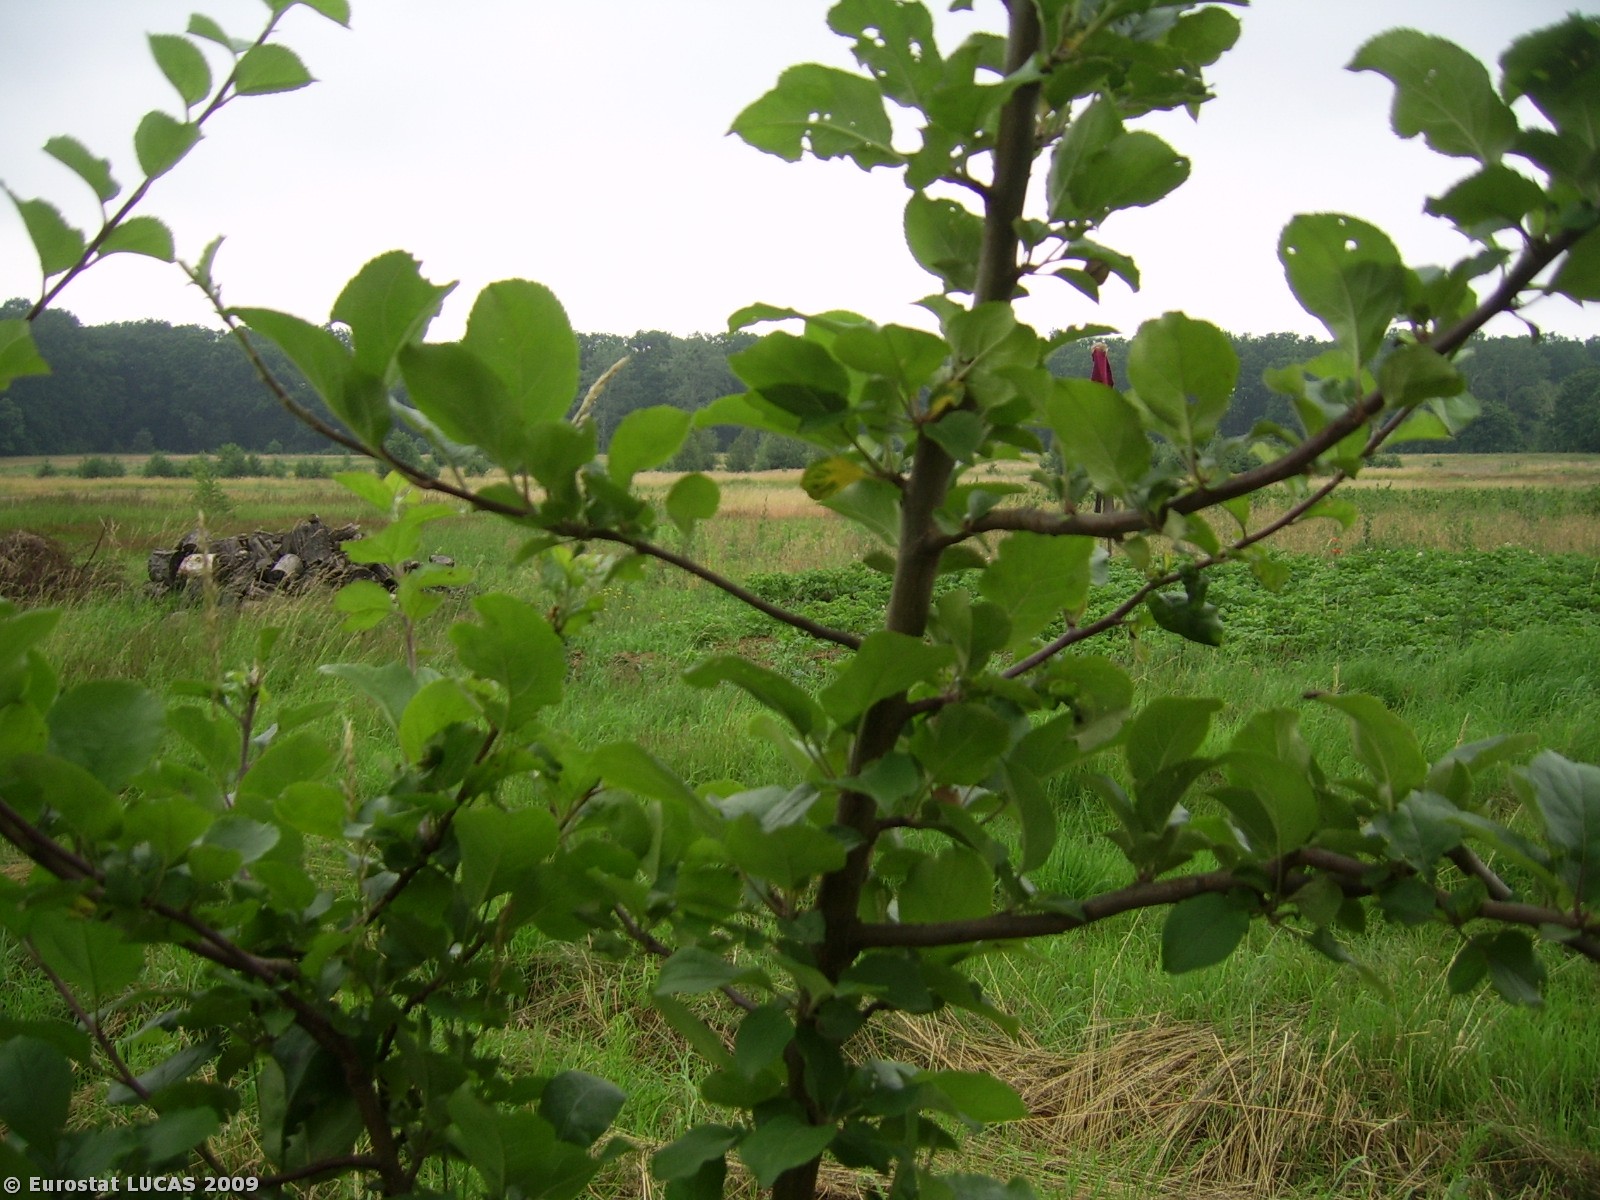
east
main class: Cropland
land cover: Common wheat
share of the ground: > 75 %
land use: Agriculture (excluding fallow land and kitchen gardens)
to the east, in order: Common wheat; Potatoes; Grassland without tree/shrub cover; Electric lines; Grassland without tree/shrub cover; Paved roads, cycling and walking lanes; Grass margins; Ditches and canals; Grassland without tree/shrub cover; Grassland with sparse tree/shrub cover; Grassland without tree/shrub cover; Rye
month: June
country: PL
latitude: 51.5000
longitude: 17.3443
